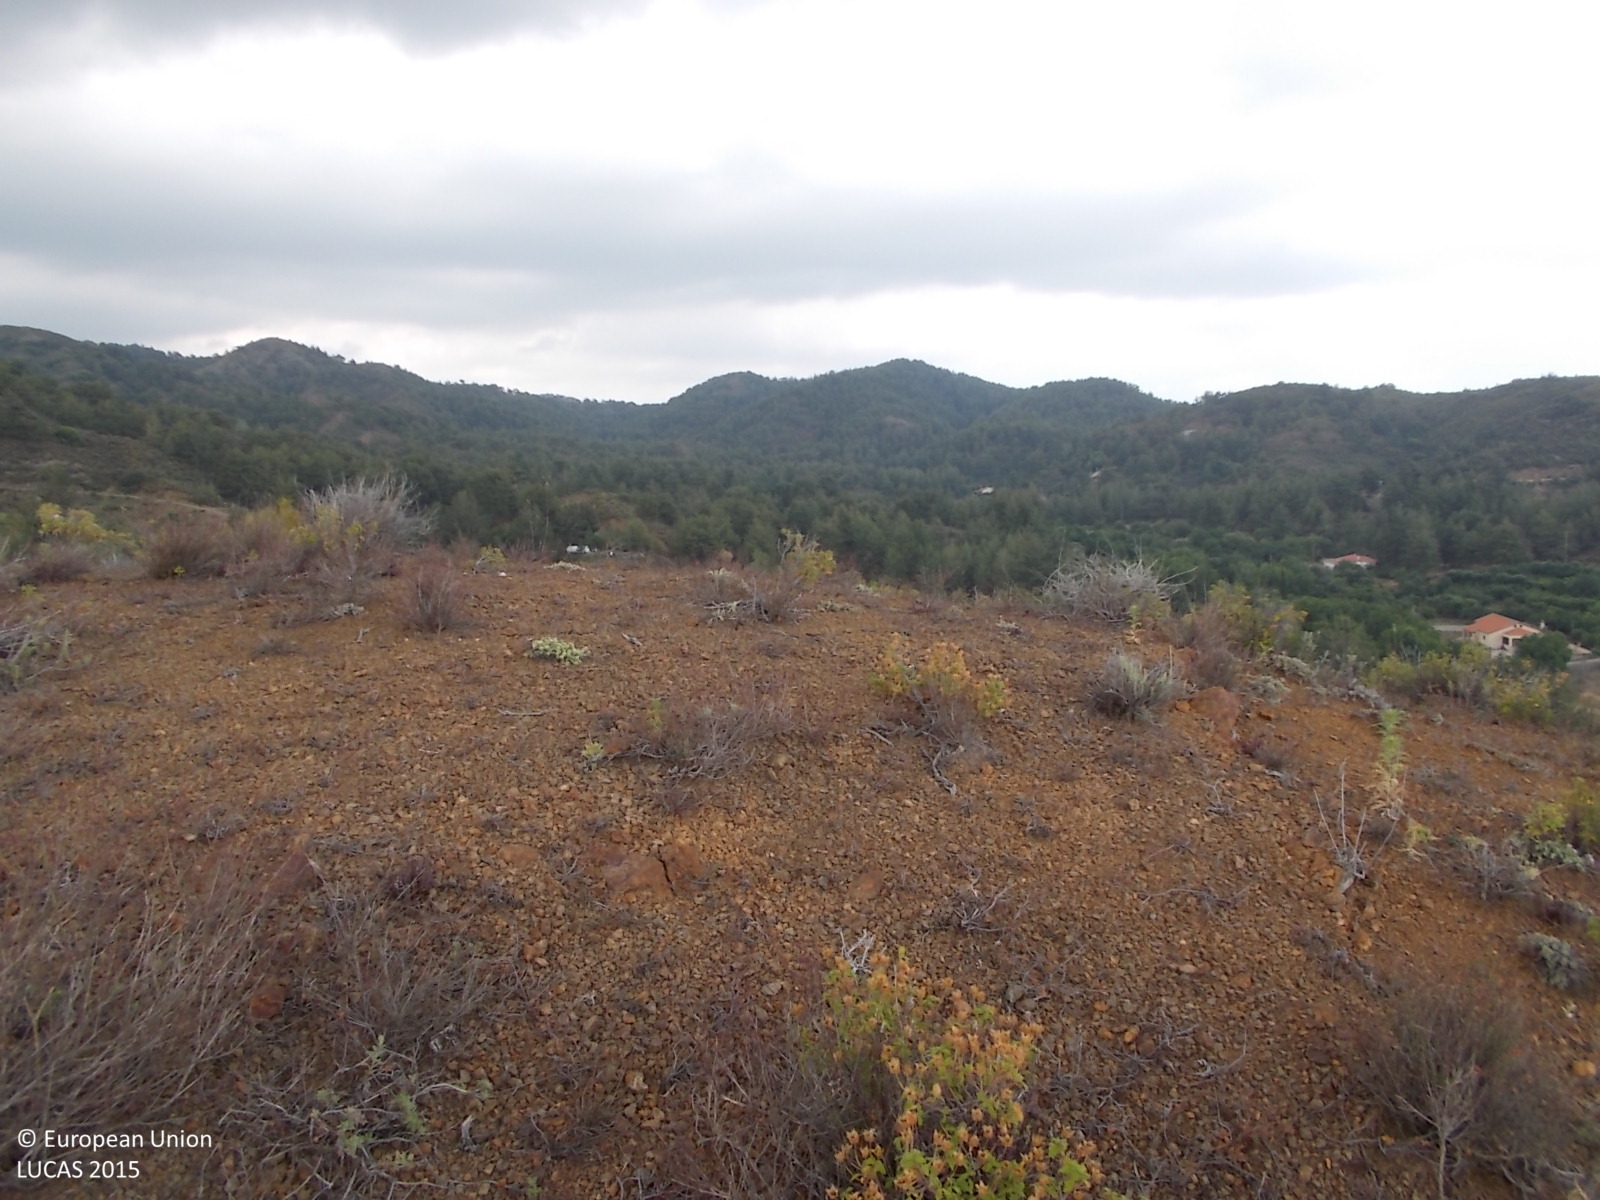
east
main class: Shrubland
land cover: Shrubland without tree cover
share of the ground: 10 - 25 %
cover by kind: unconsolidated bare surface 80 %, shrubs 20 %
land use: Semi-natural and natural areas not in use
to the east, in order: Shrubland without tree cover; Pine dominated coniferous woodland; Shrubland with sparse tree cover; Shrubland without tree cover; Tracks; Grassland with sparse tree/shrub cover; Shrubland without tree cover; Nuts trees; Grassland with sparse tree/shrub cover; Tracks; Nuts trees; Other fruit trees and berries; Apple fruit; Cherry fruit; Abandoned hedges; Vineyards
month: June
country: CY
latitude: 34.8718
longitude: 32.8415
